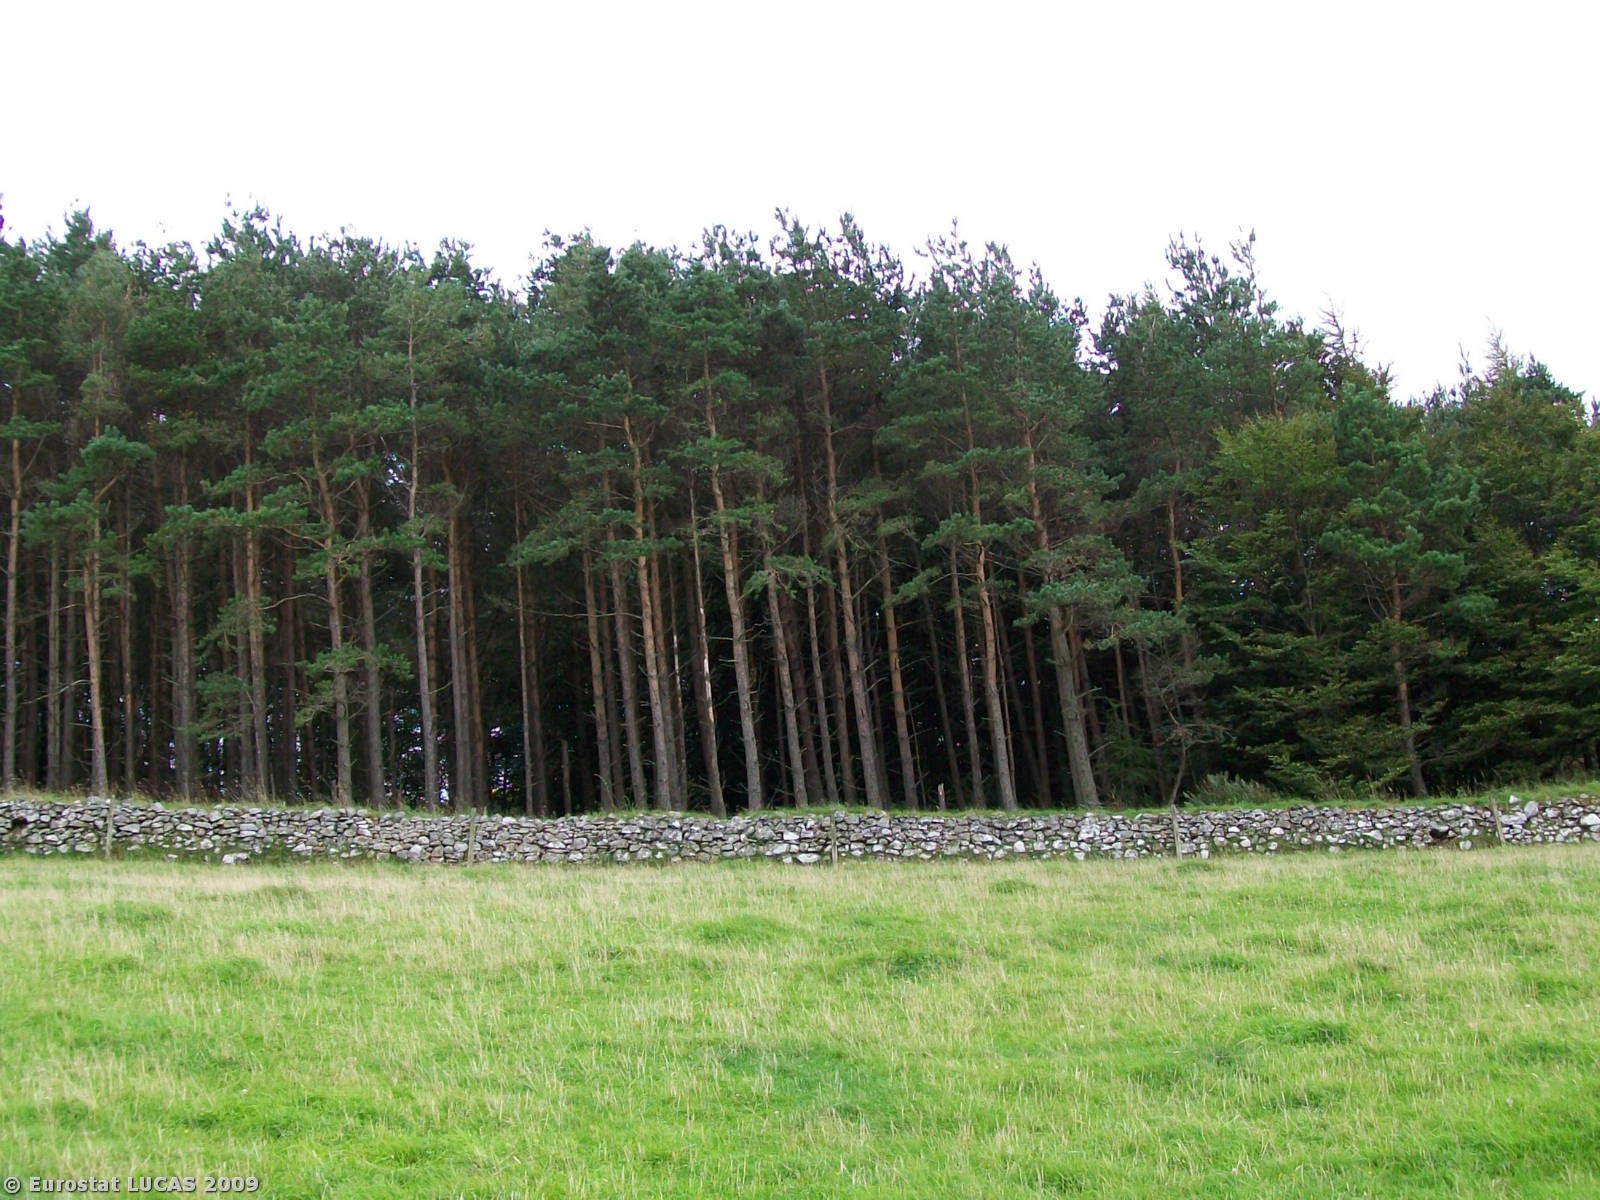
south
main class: Grassland
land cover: Grassland without tree/shrub cover
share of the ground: > 75 %
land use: Agriculture (excluding fallow land and kitchen gardens)
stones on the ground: < 10 %
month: September
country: GB
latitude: 55.8268
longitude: -2.3329
